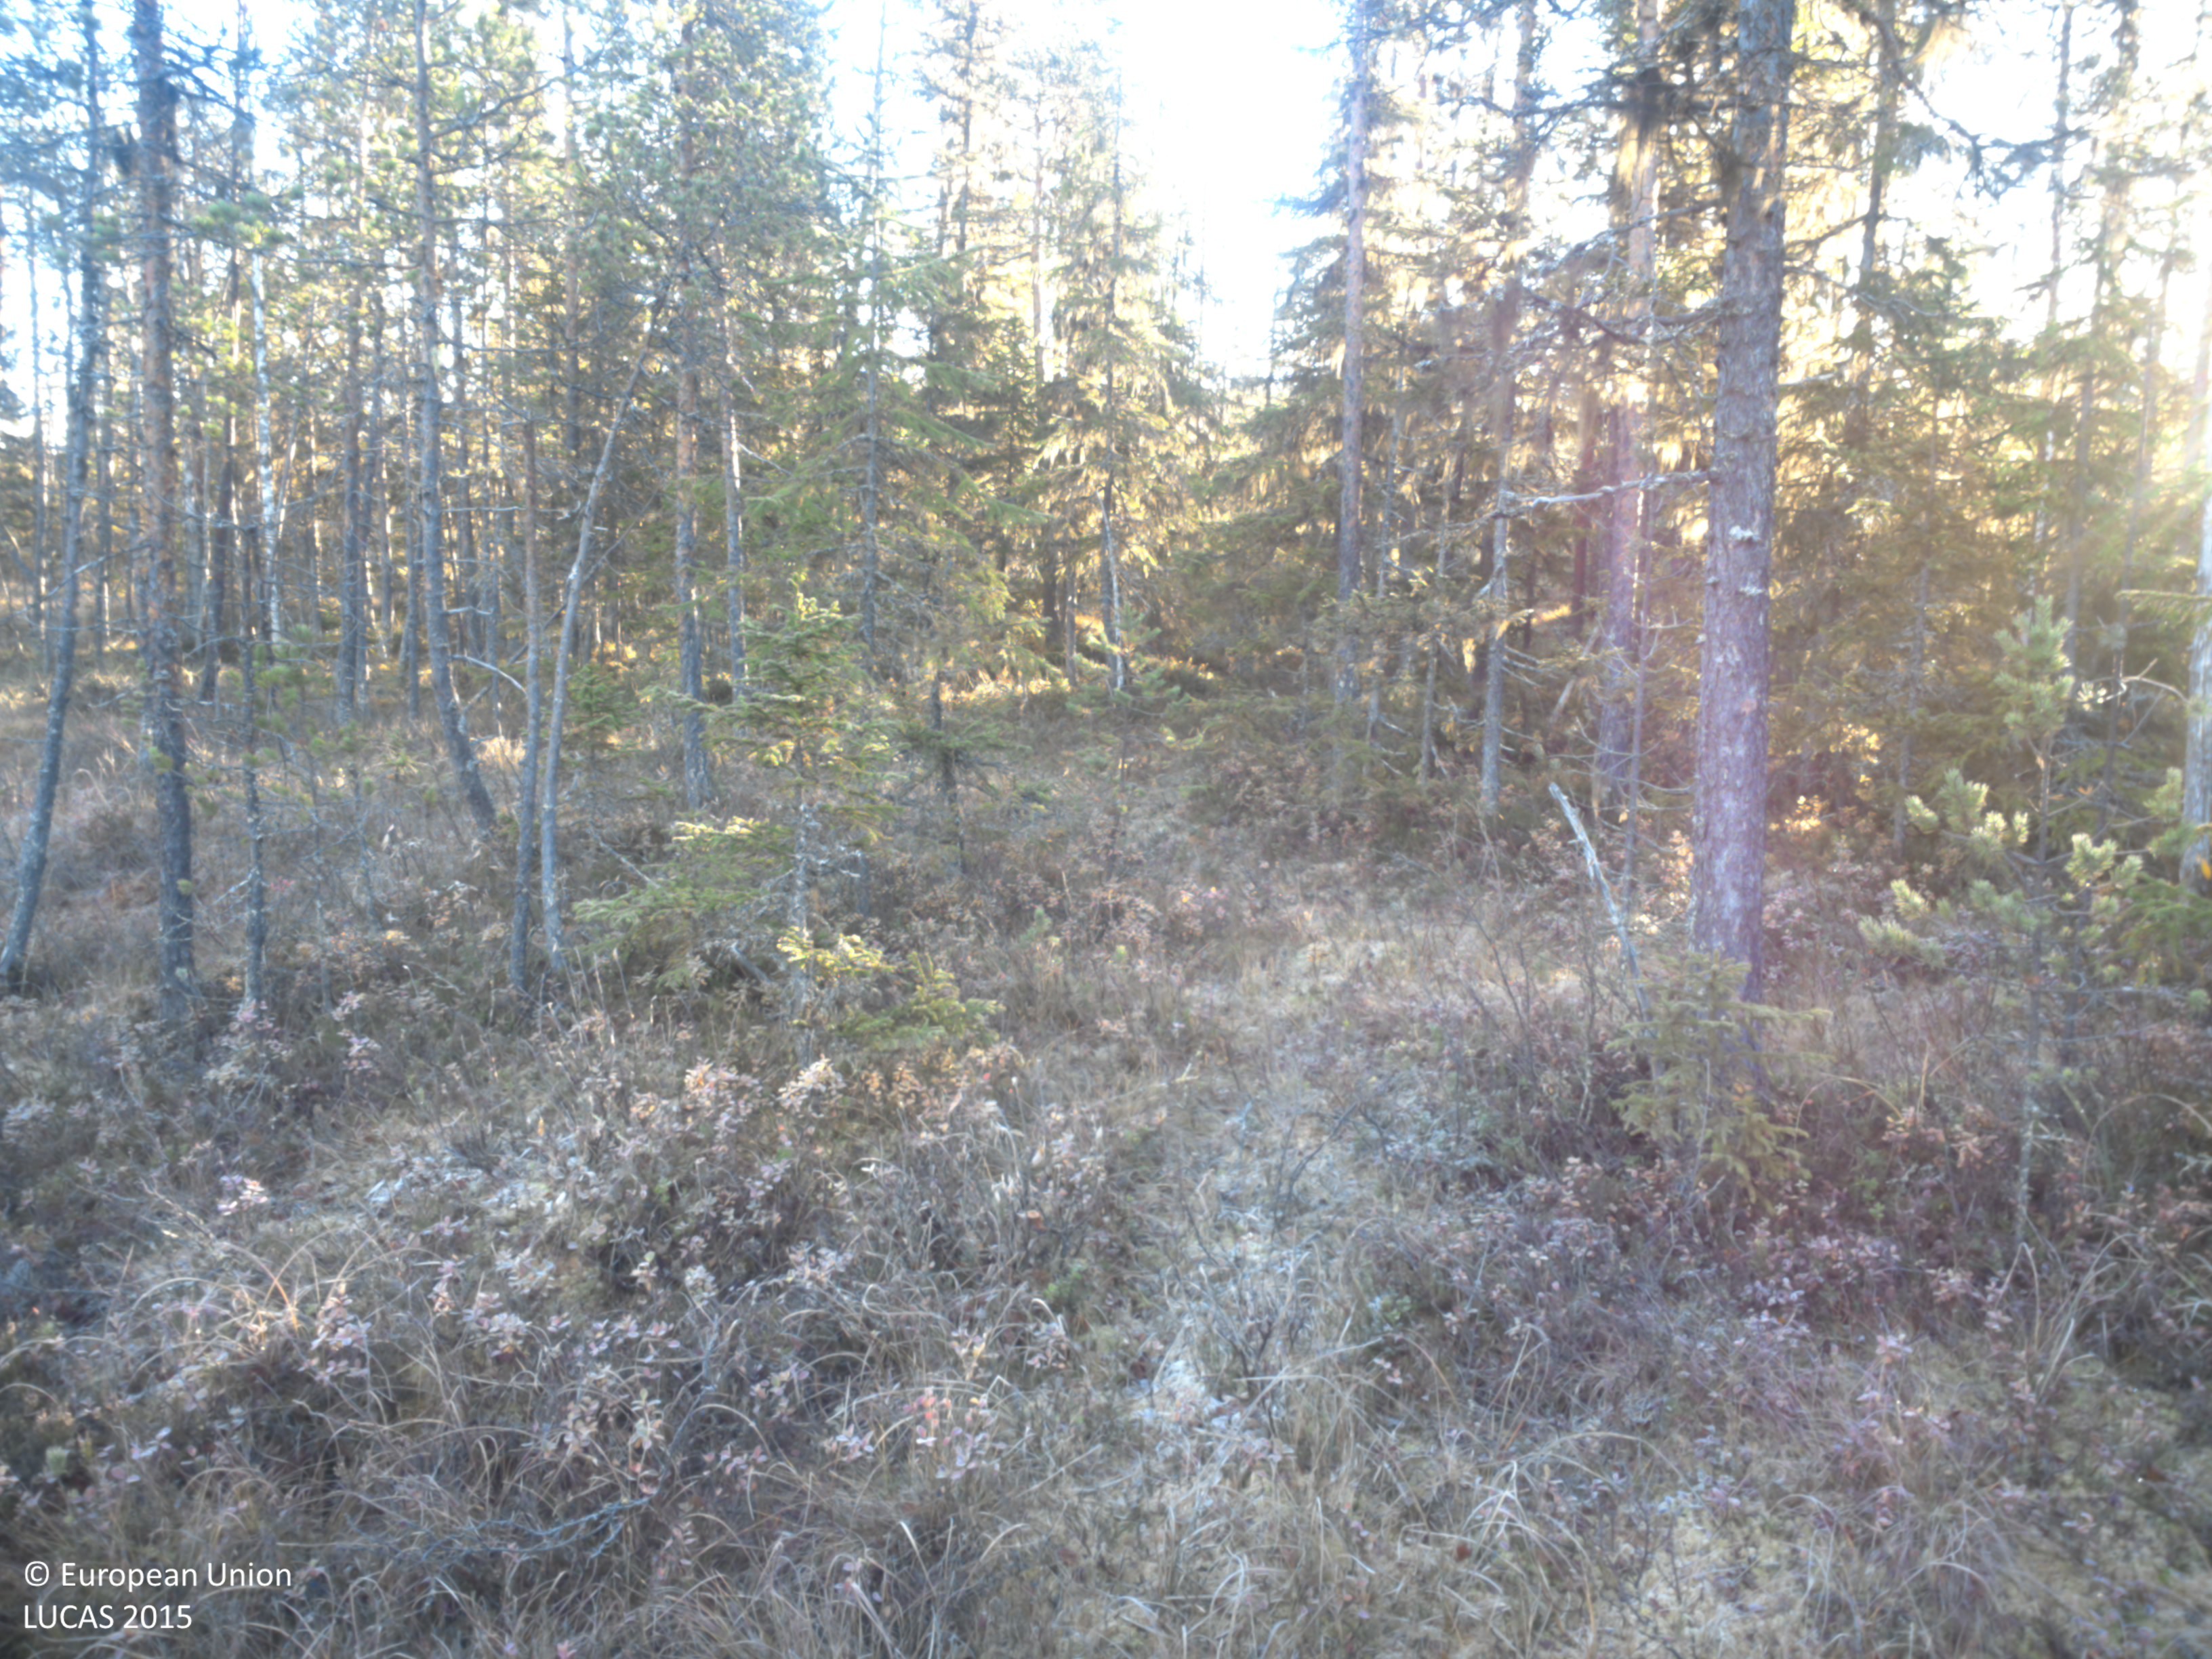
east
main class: Woodland
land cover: Pine dominated mixed woodland
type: boreal forest
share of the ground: 25 - 50 %
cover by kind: coniferous forest trees 30 %, shrubs 25 %, herbaceous plants 25 %, broadleaved forest trees 10 %, lichens and mosses 10 %
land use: Forestry
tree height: < 5 m
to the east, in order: Pine dominated mixed woodland; Spruce dominated mixed woodland; Pine dominated coniferous woodland
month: October
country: SE
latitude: 64.8019
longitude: 18.2385
